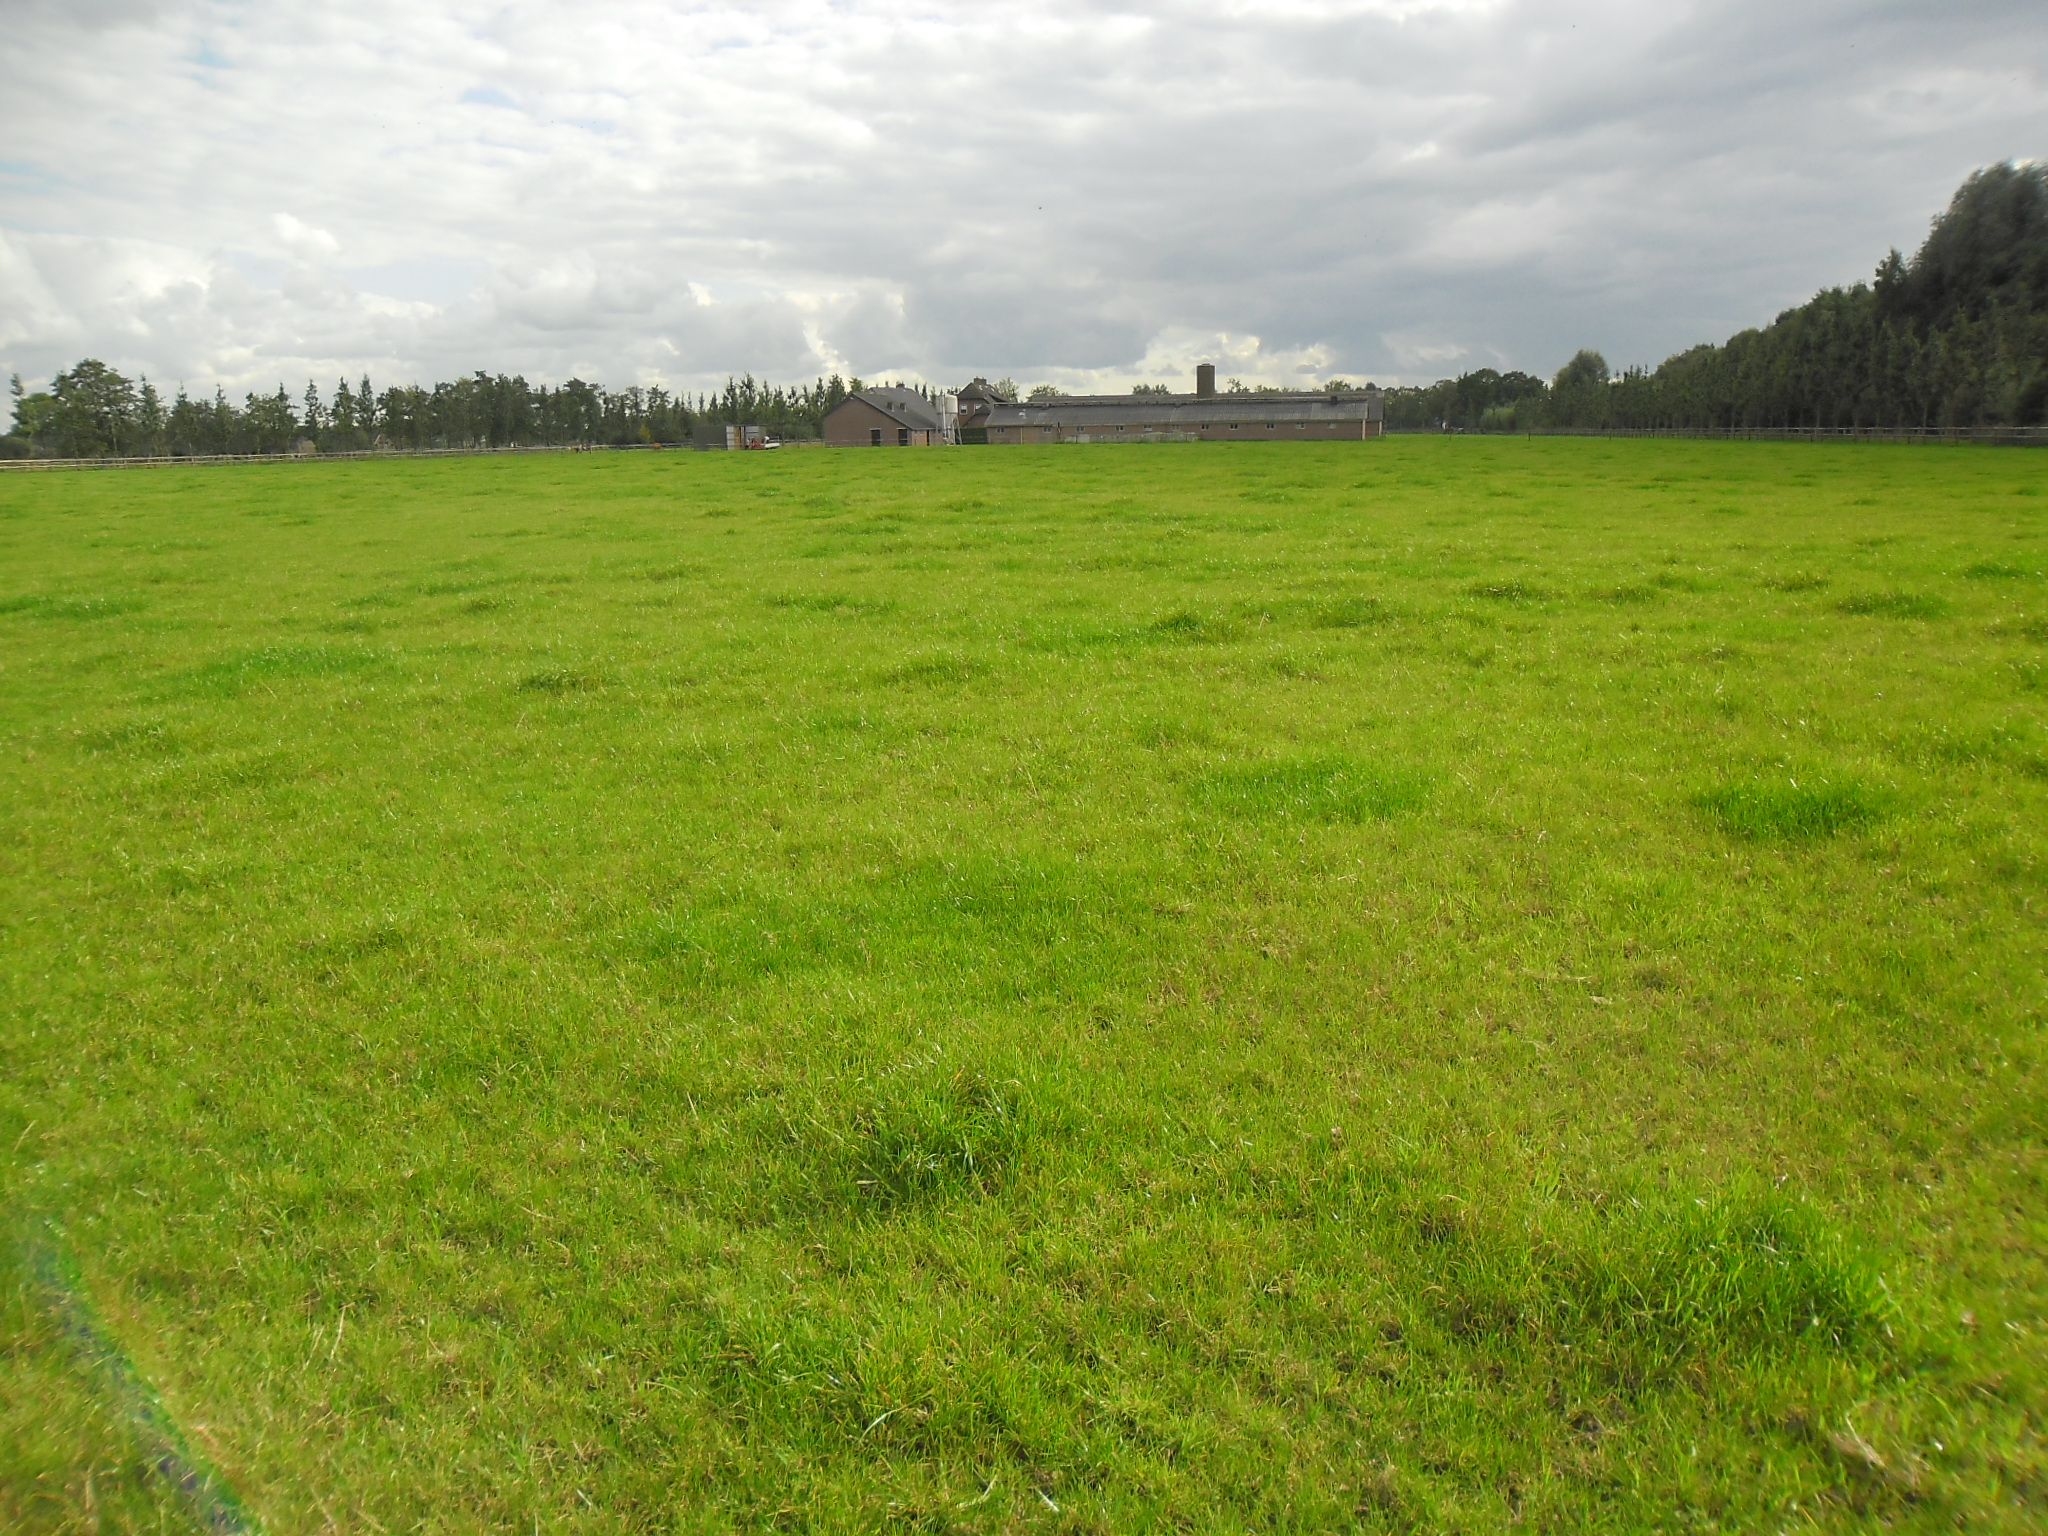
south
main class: Grassland
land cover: Grassland without tree/shrub cover
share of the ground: > 75 %
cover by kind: herbaceous plants 100 %
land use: Agriculture (excluding fallow land and kitchen gardens)
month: September
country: NL
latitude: 52.1834
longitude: 5.4789
